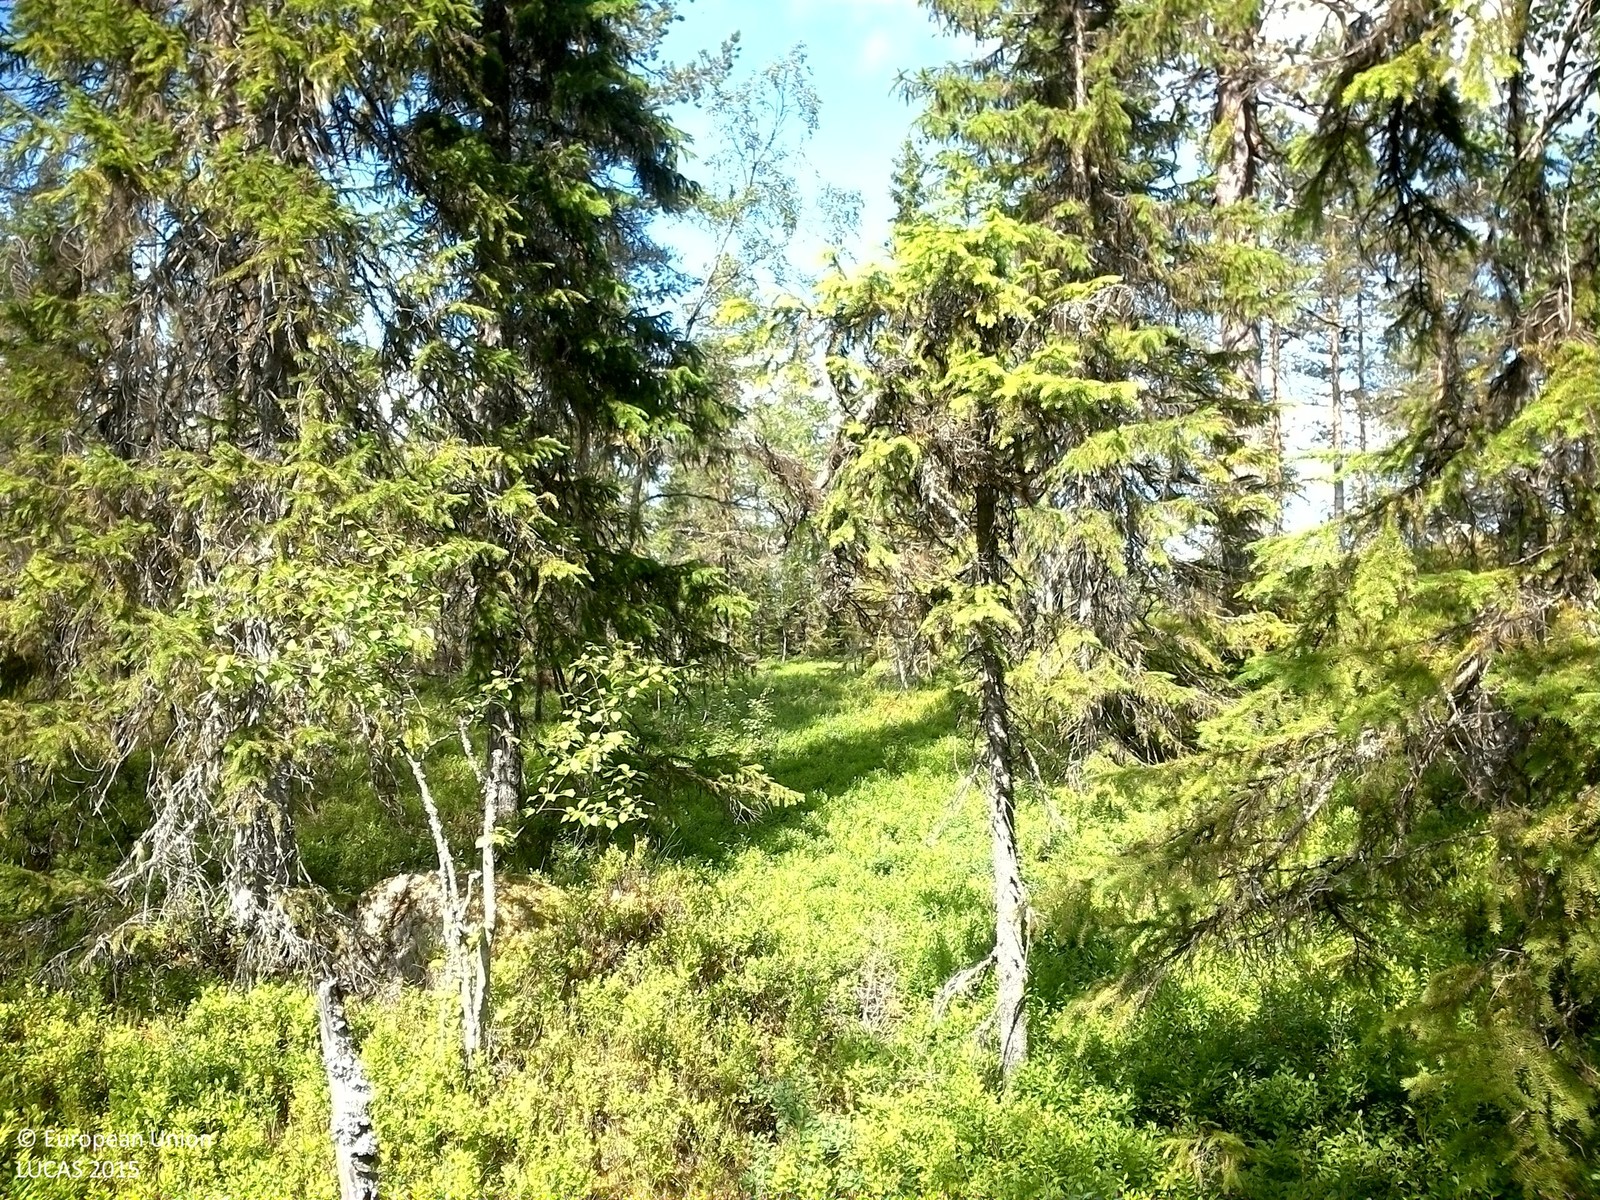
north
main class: Woodland
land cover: Pine dominated coniferous woodland
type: boreal forest
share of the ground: 25 - 50 %
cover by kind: shrubs 40 %, coniferous forest trees 30 %, lichens and mosses 20 %, broadleaved forest trees 5 %, herbaceous plants 5 %
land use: Forestry
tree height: > 5 m
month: July
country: SE
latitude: 63.5228
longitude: 17.6738
